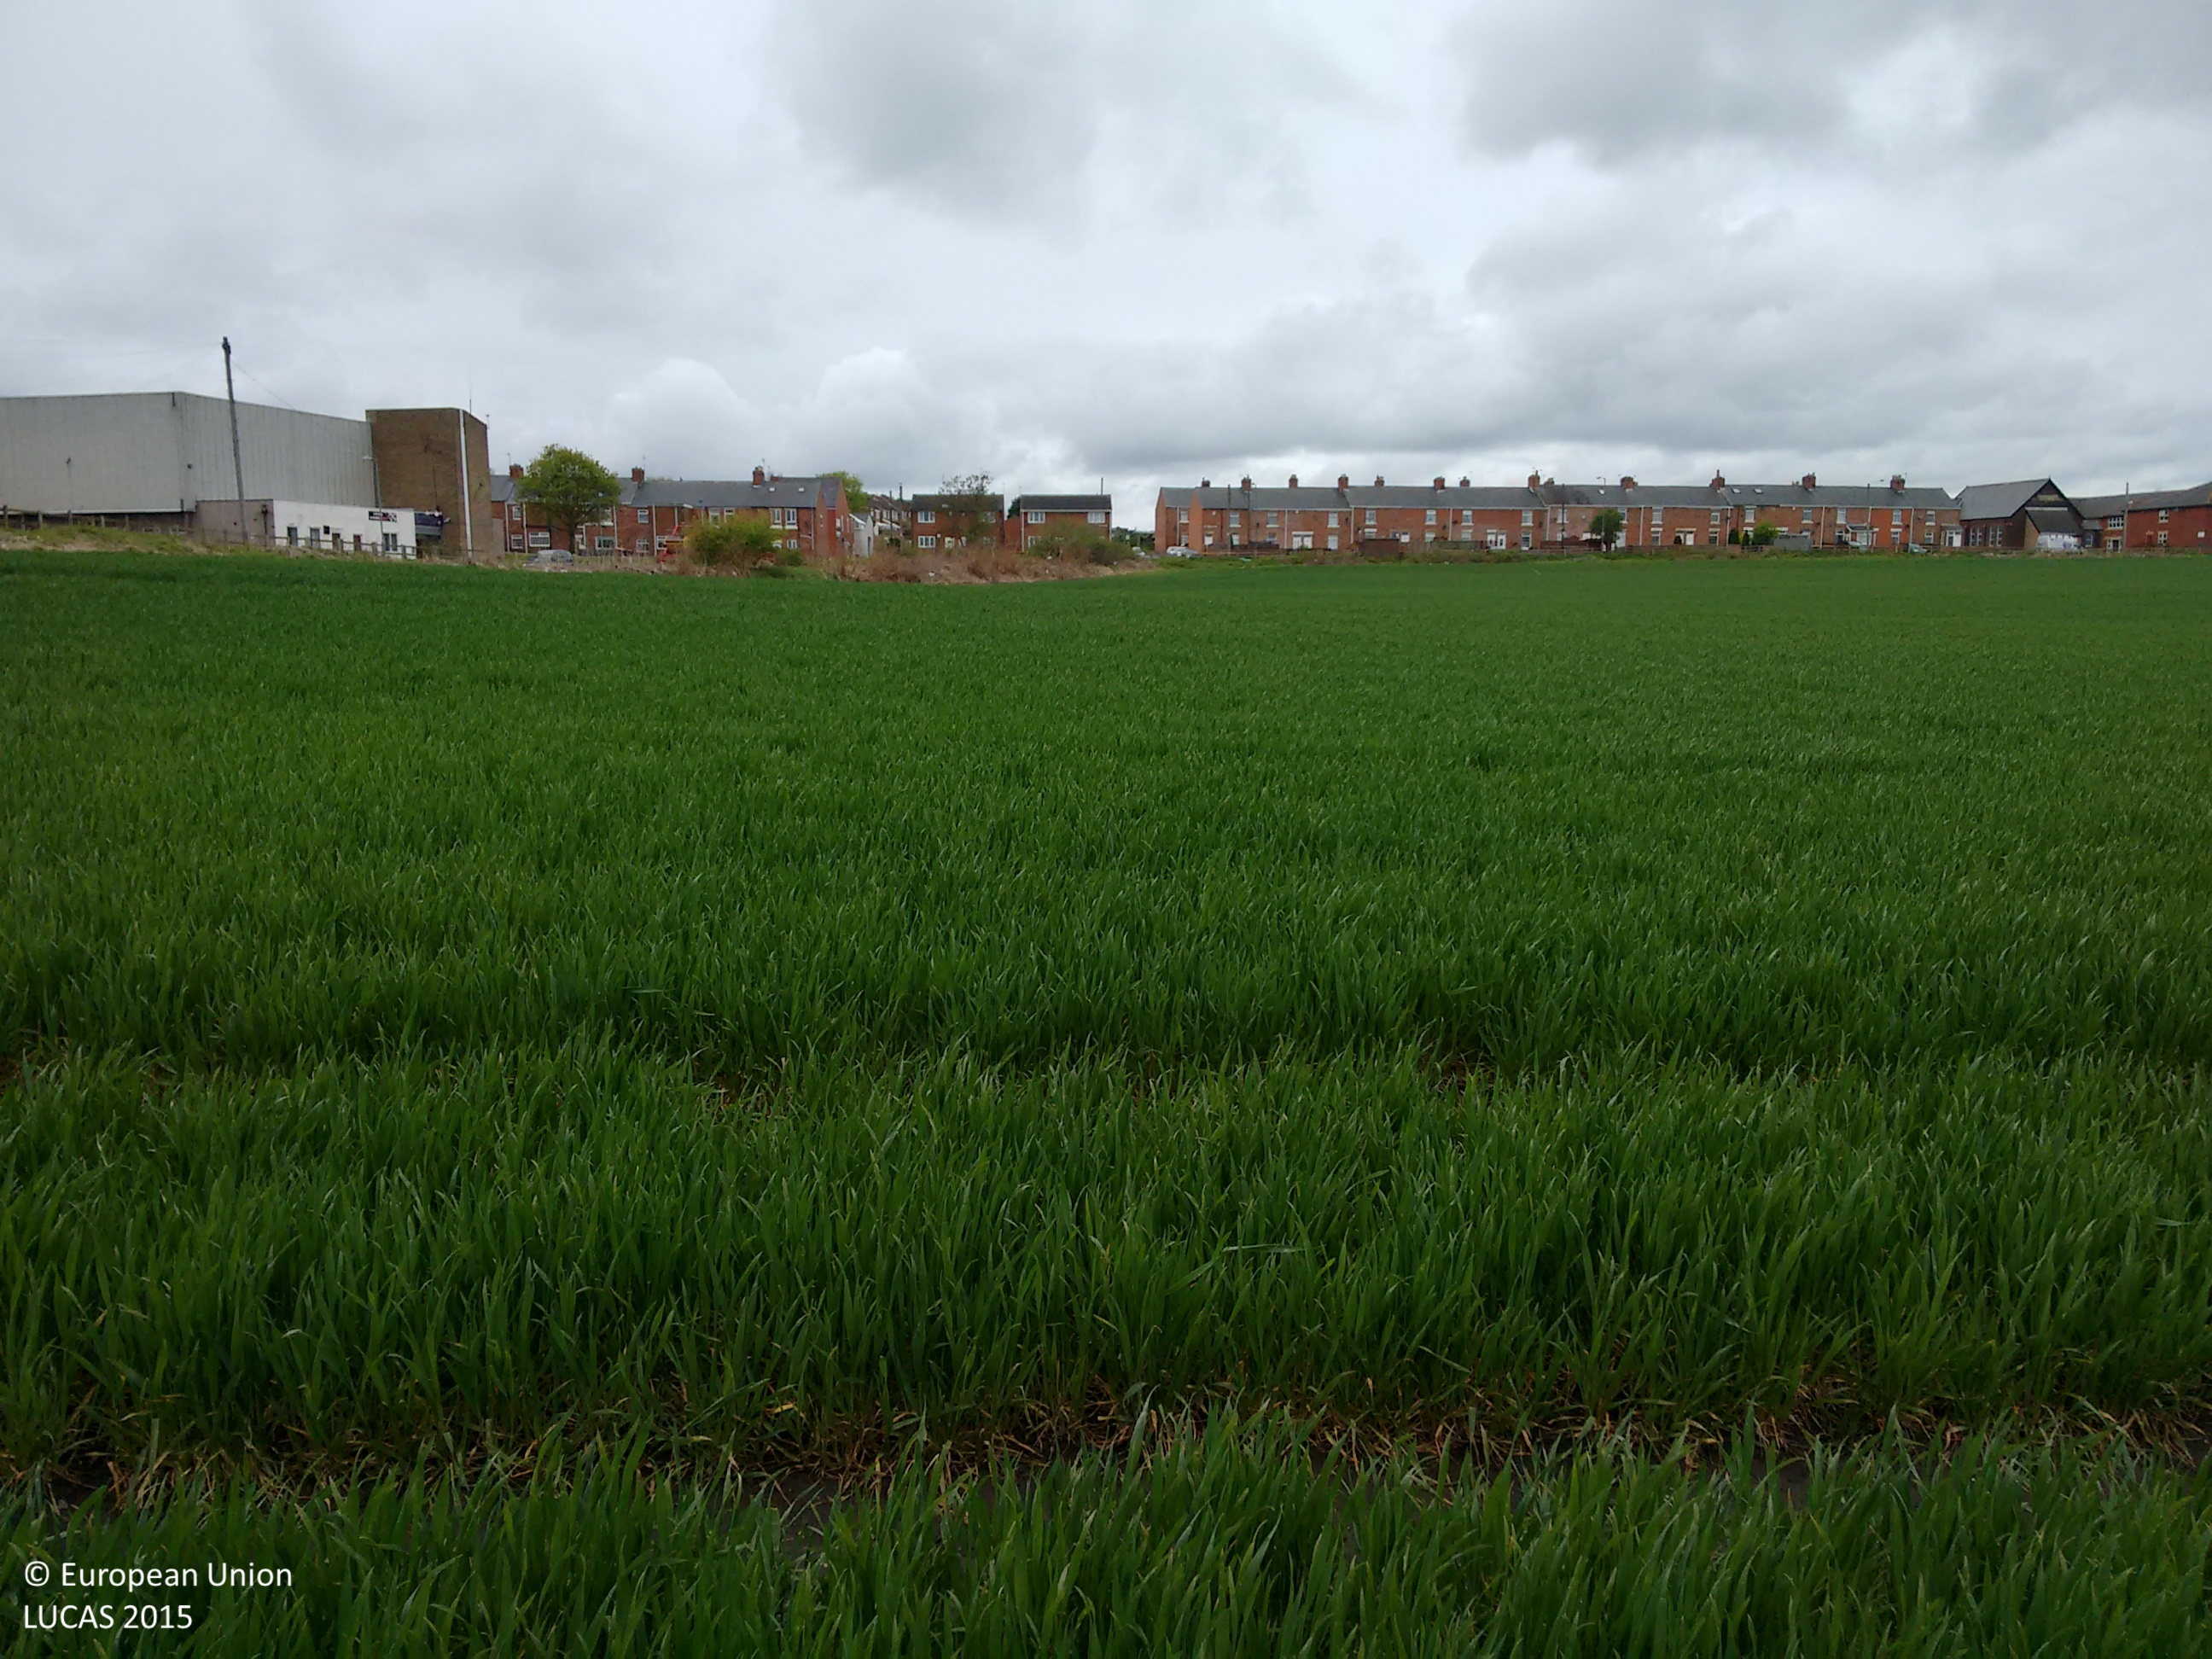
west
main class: Cropland
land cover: Common wheat
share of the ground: > 75 %
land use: Agriculture (excluding fallow land and kitchen gardens)
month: May
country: GB
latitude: 54.8780
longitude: -1.5979
